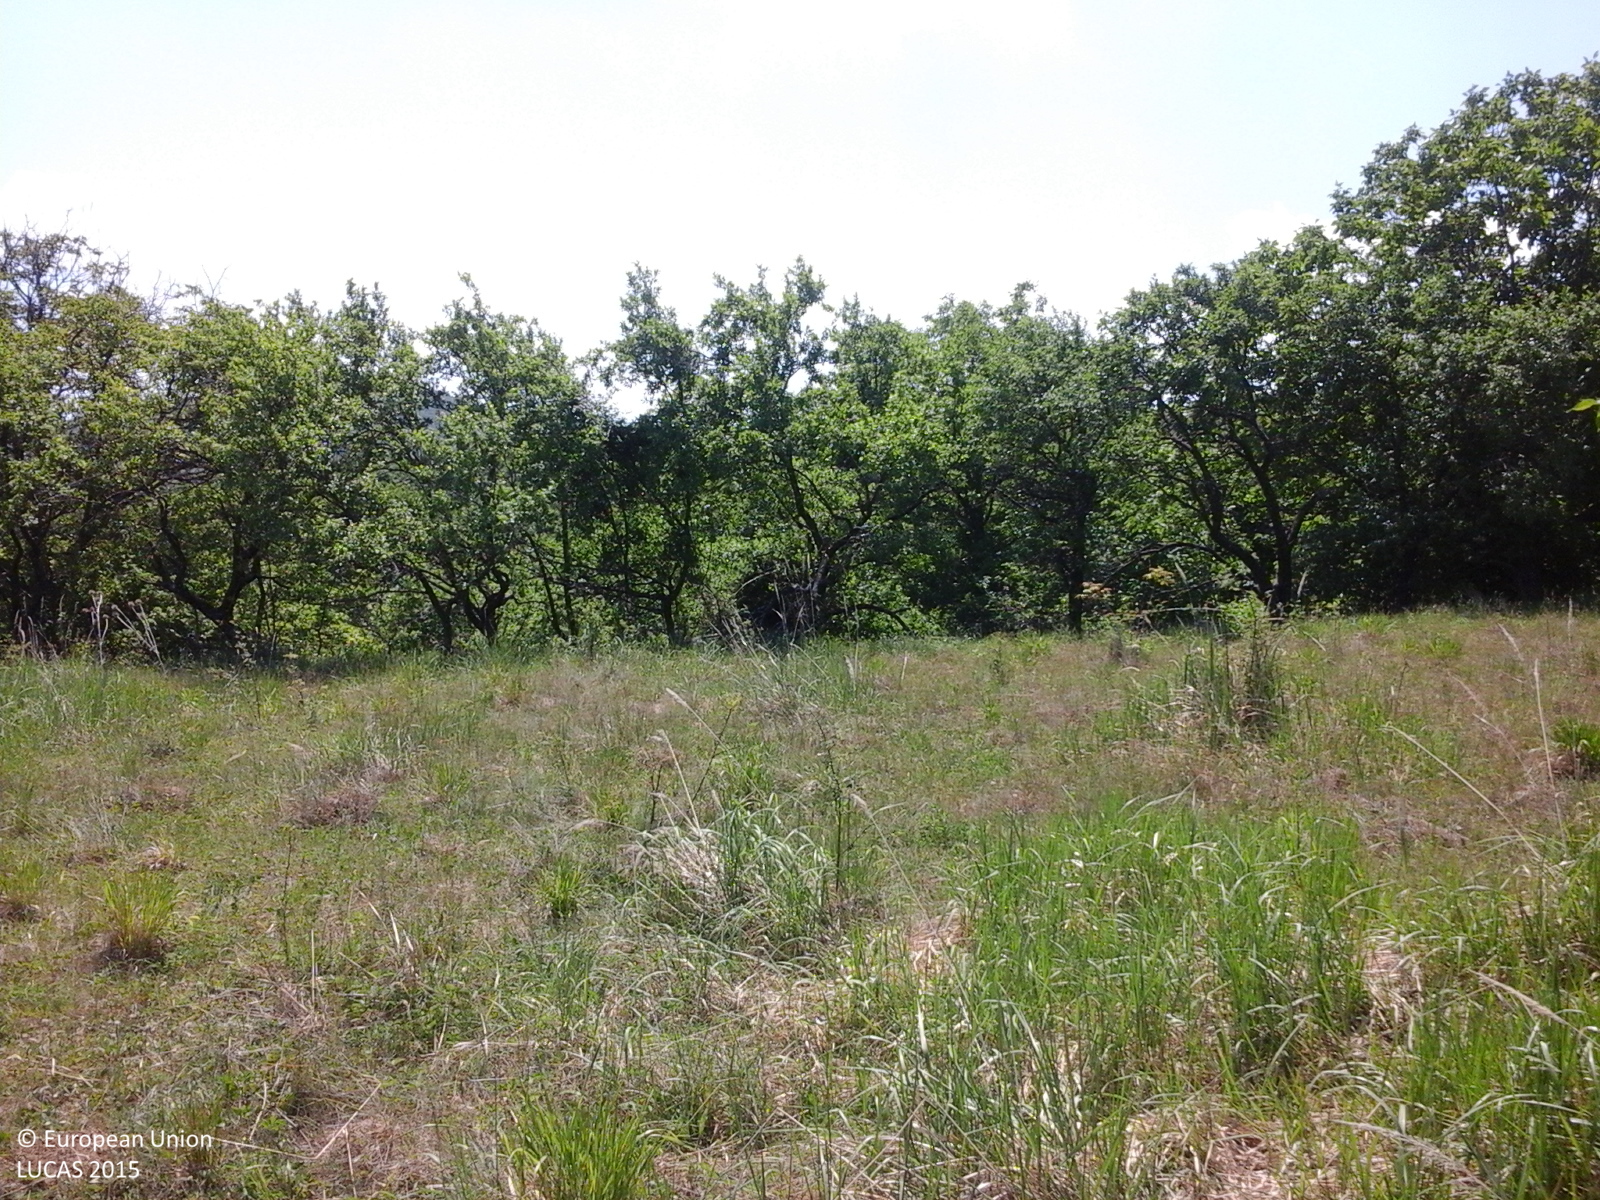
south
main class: Grassland
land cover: Grassland without tree/shrub cover
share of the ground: > 75 %
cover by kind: herbaceous plants 95 %, shrubs 5 %
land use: Agriculture (excluding fallow land and kitchen gardens)
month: June
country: RO
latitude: 46.3459
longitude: 26.8389
